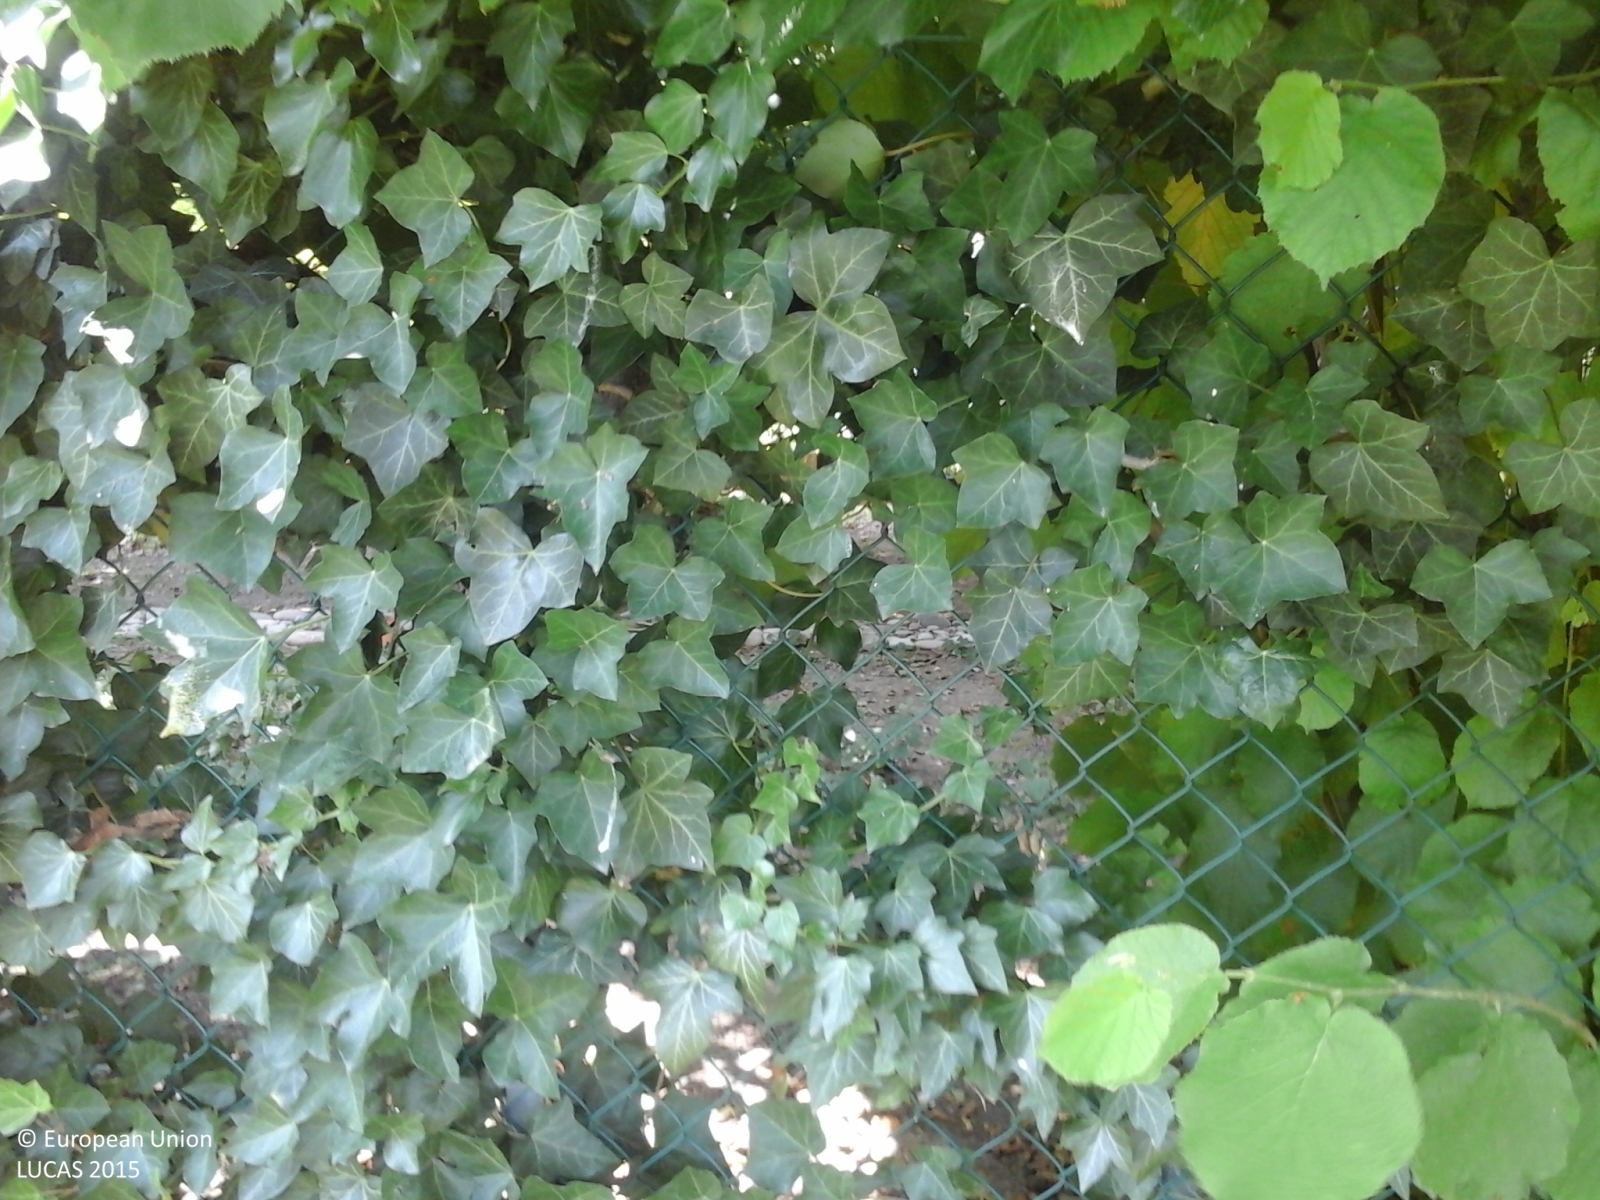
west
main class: Grassland
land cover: Grassland with sparse tree/shrub cover
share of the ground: > 75 %
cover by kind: herbaceous plants 95 %, broadleaved forest trees 5 %
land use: Residential
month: June
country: IT
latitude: 44.7613
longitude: 10.9203
